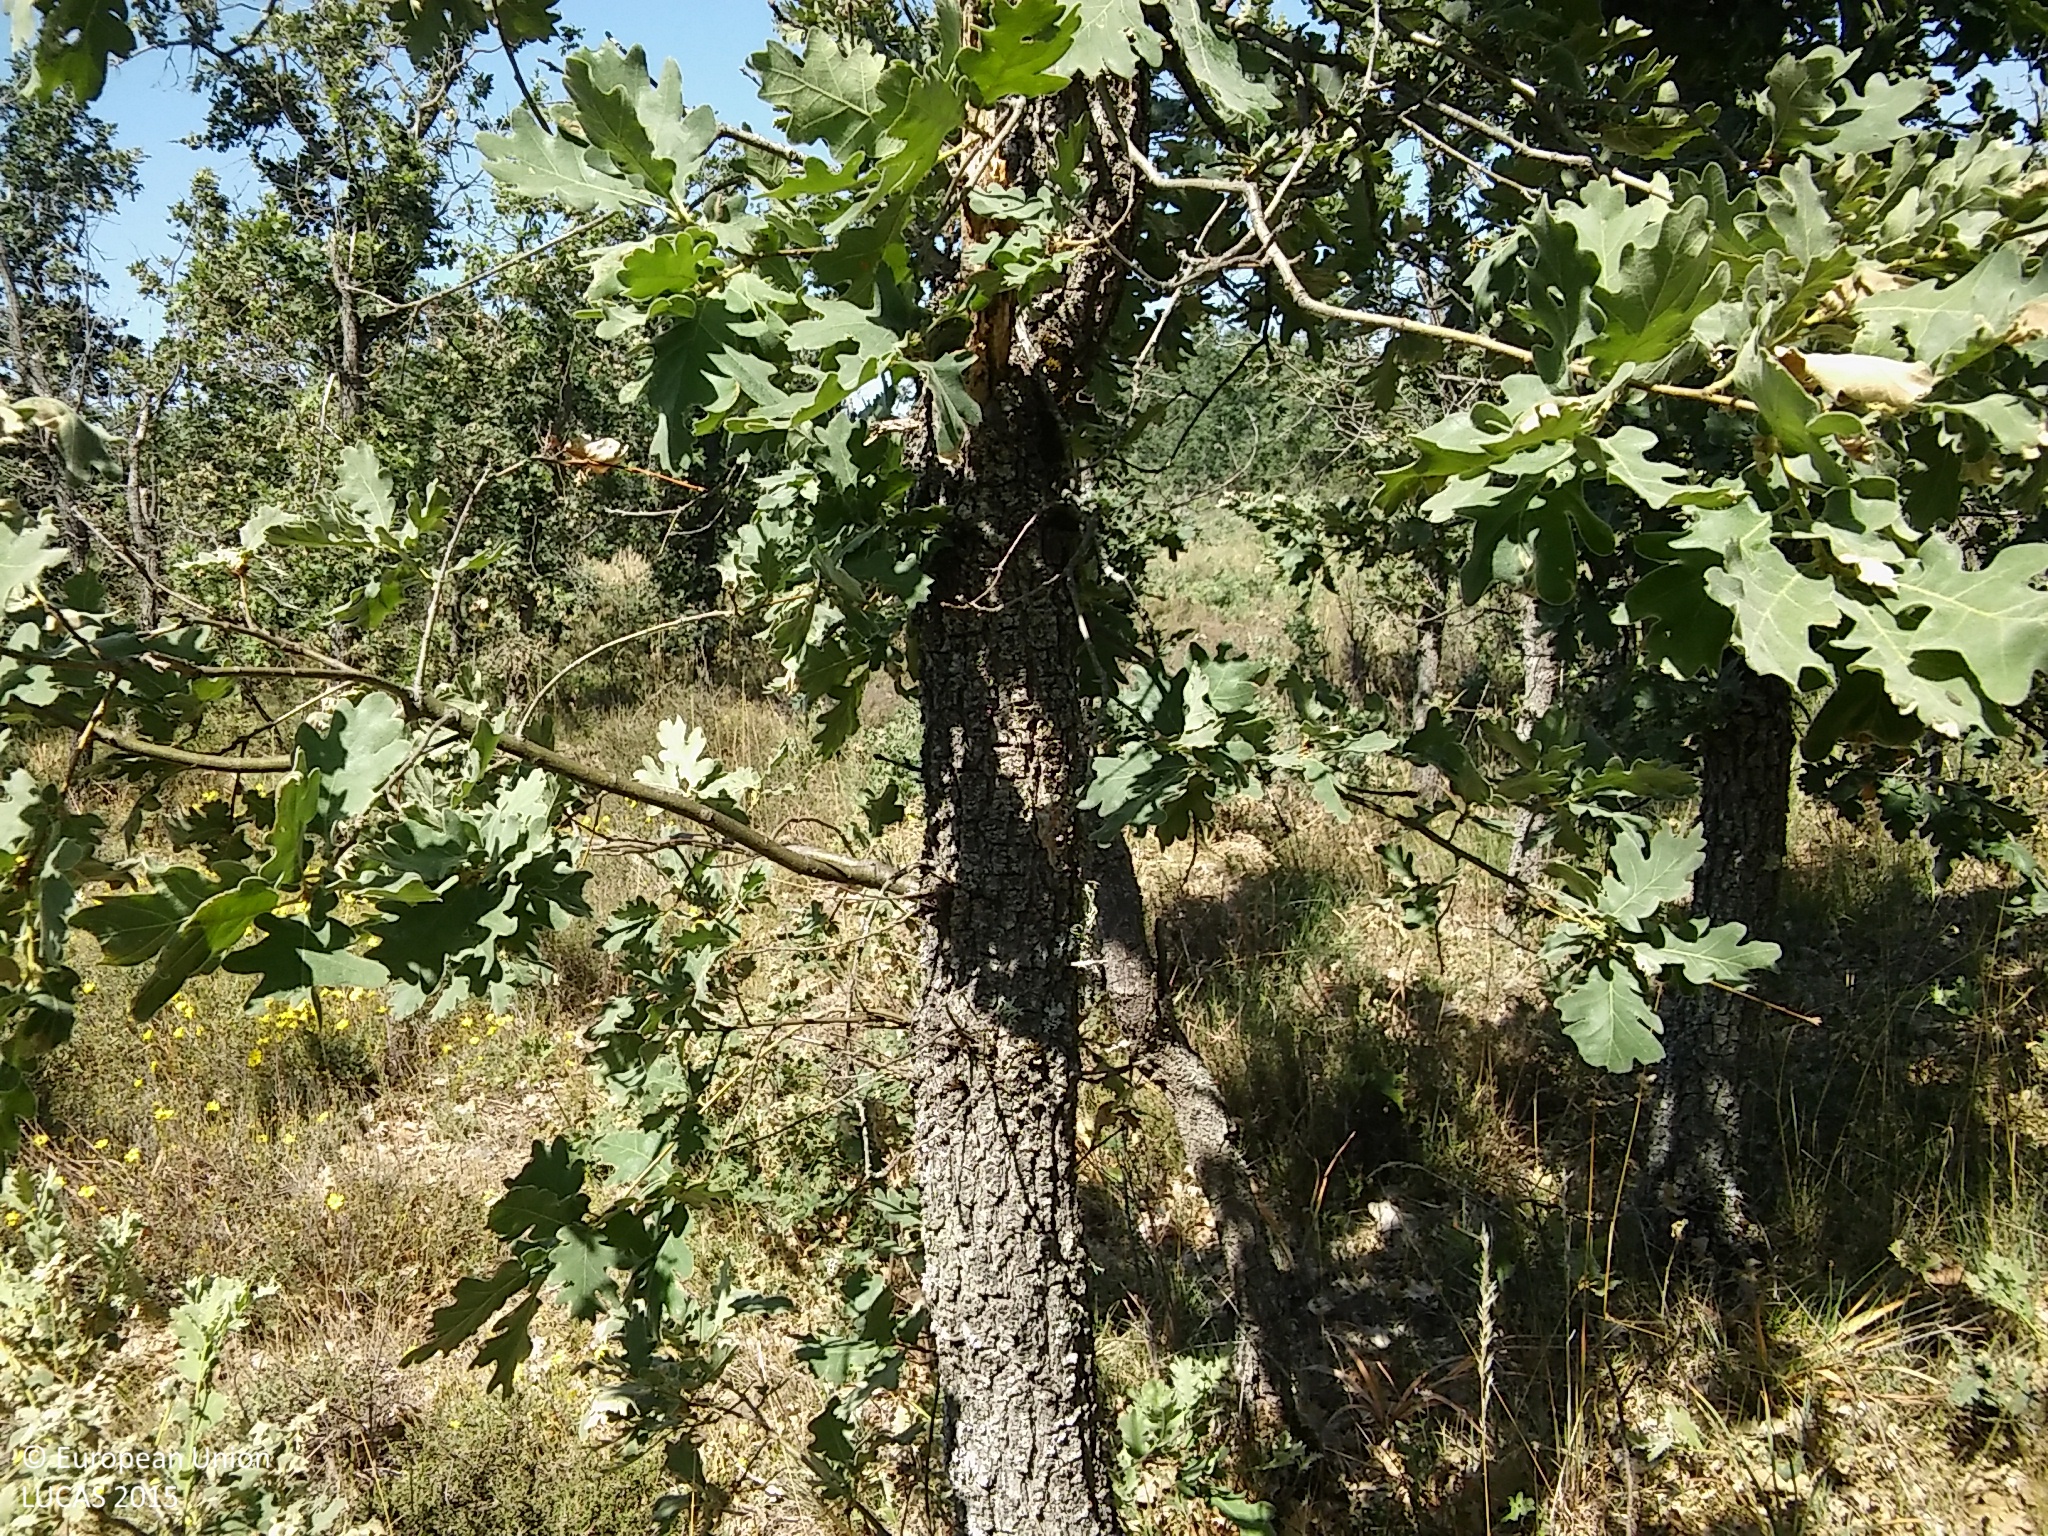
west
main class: Woodland
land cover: Broadleaved woodland
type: acidophilous oak and oak-birch forest
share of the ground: 50 - 75 %
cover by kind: broadleaved forest trees 50 %, shrubs 30 %, herbaceous plants 10 %, unconsolidated bare surface 10 %
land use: Forestry
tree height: > 5 m
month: July
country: ES
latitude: 41.3089
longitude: -3.4831
